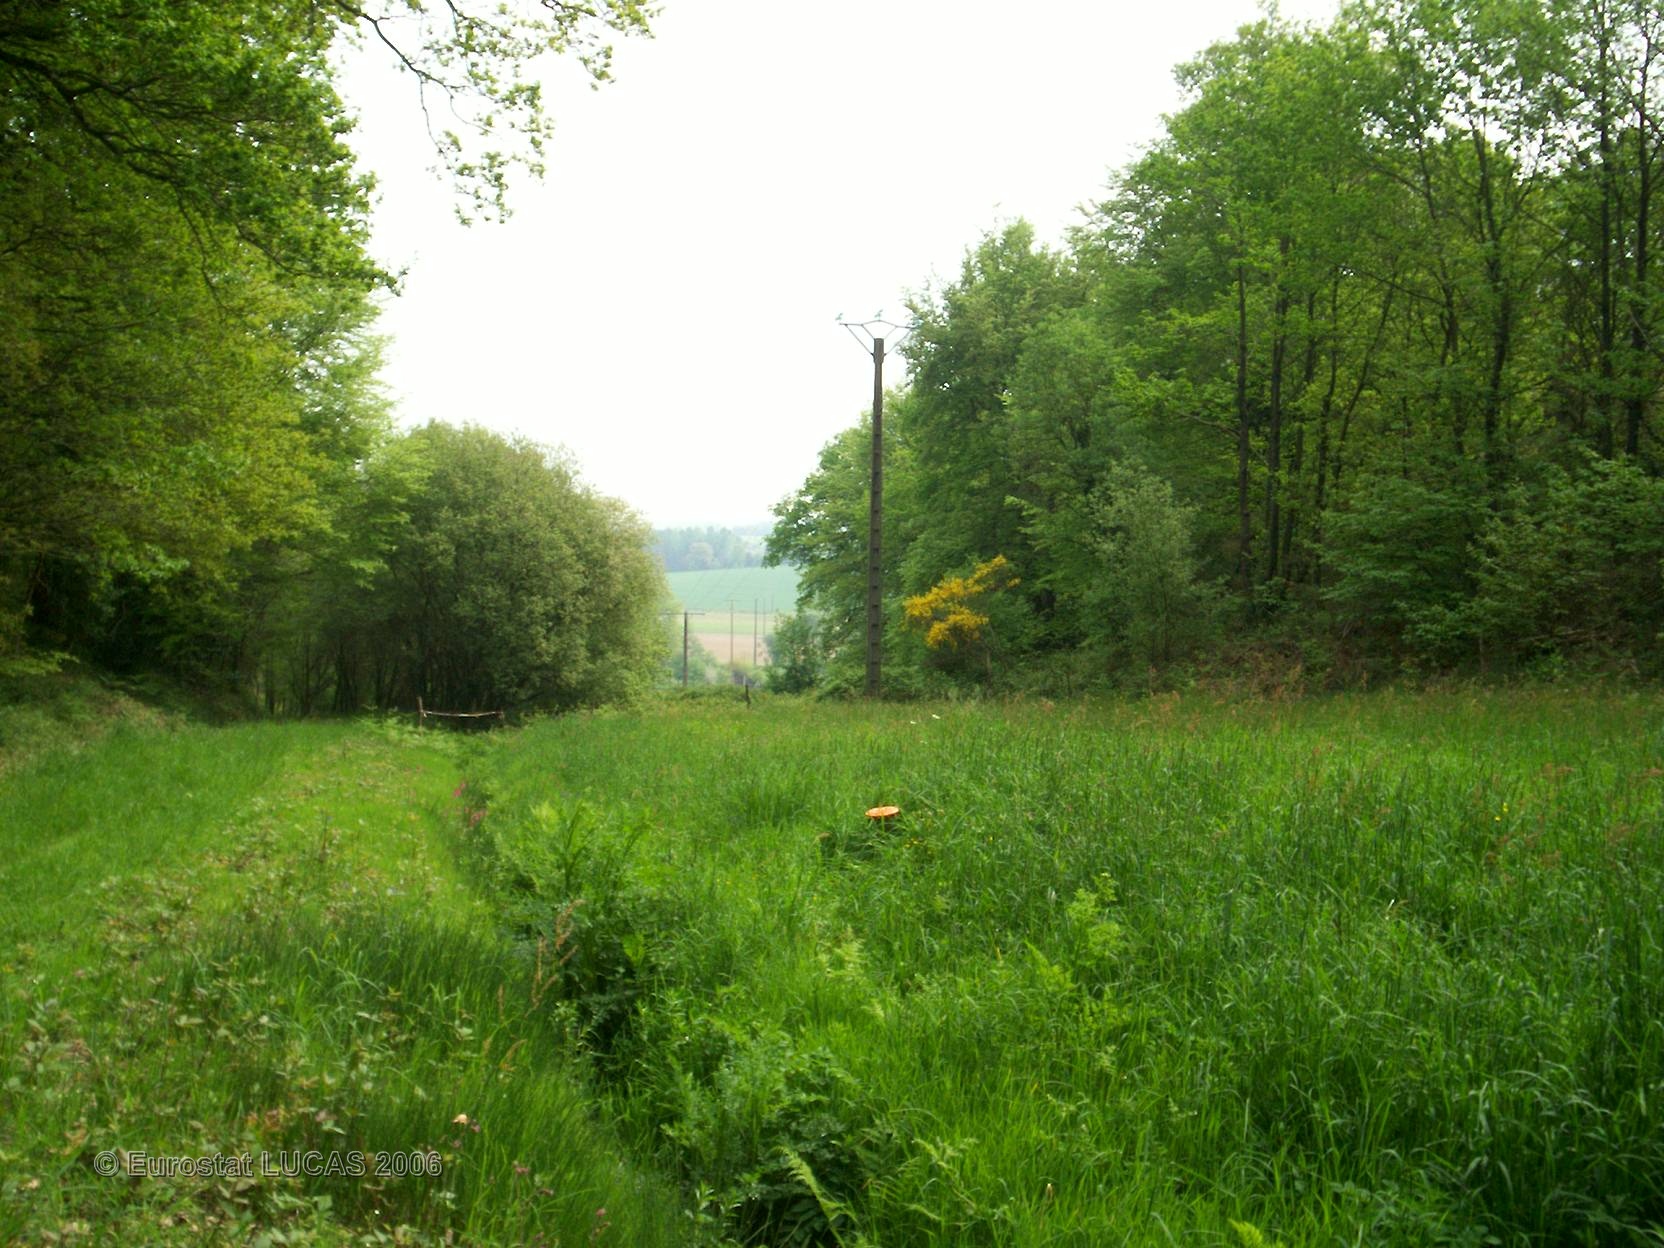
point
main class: Grassland
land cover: Grassland without tree/shrub cover
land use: Unused
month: May
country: FR
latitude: 47.7840
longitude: -2.3218
